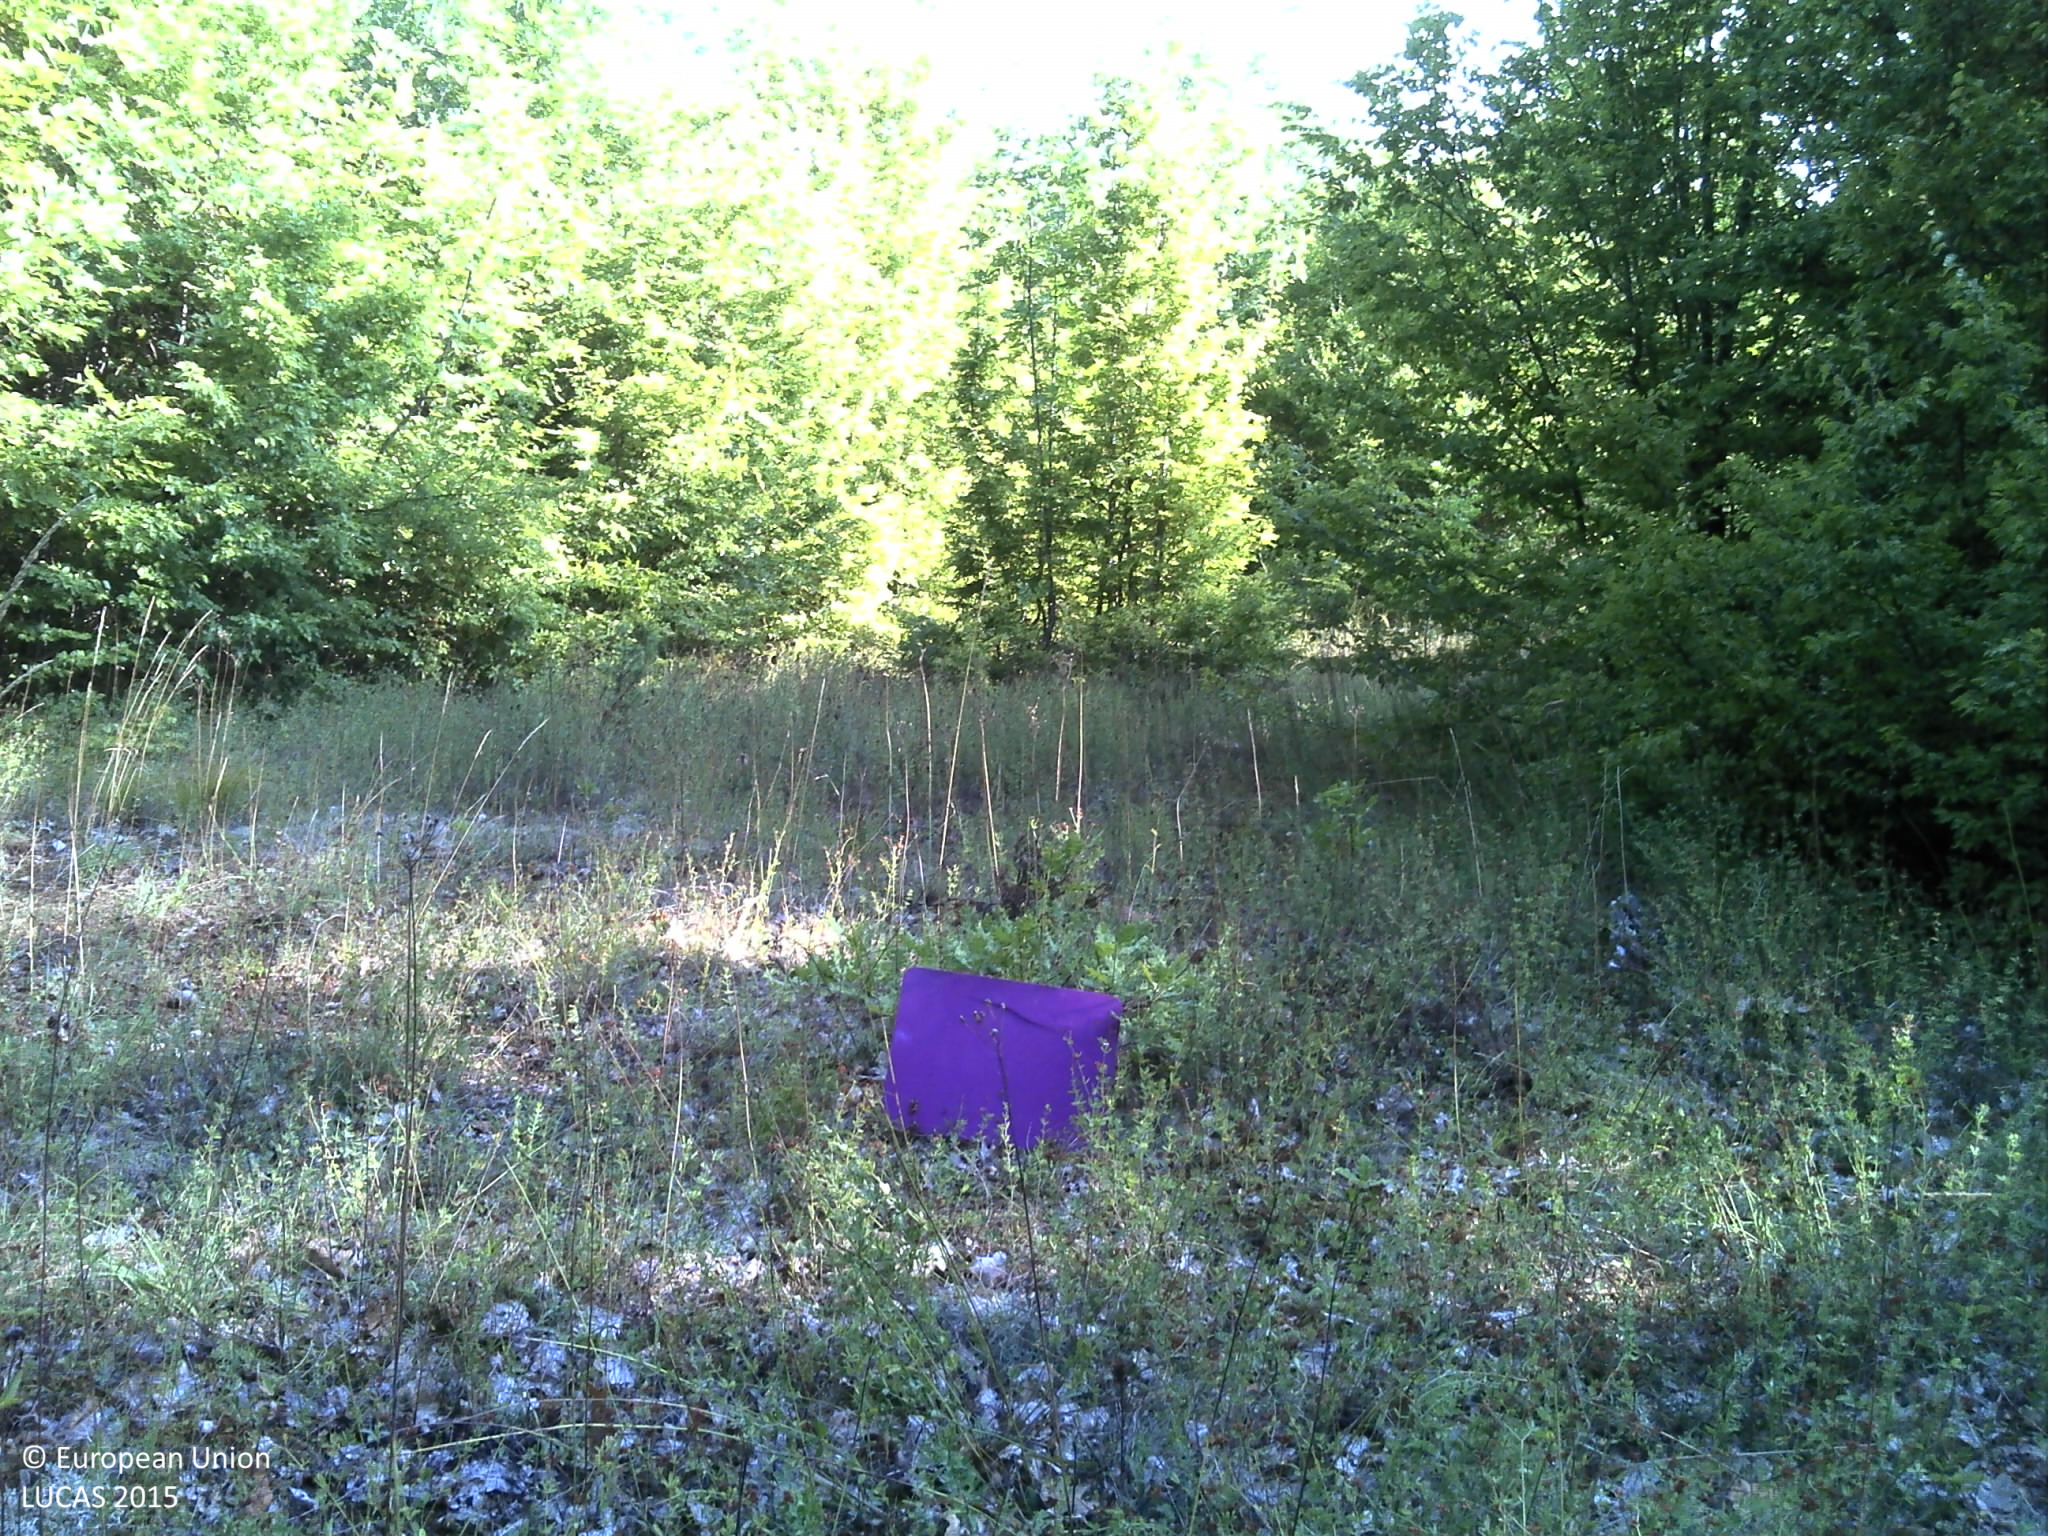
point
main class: Woodland
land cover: Other mixed woodland
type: thermophilous deciduous forest
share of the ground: > 75 %
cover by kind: broadleaved forest trees 30 %, shrubs 30 %, herbaceous plants 15 %, coniferous forest trees 10 %, unconsolidated bare surface 10 %, consolidated bare surface 5 %
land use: Semi-natural and natural areas not in use
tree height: > 5 m
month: August
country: HR
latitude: 43.3427
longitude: 17.1582
